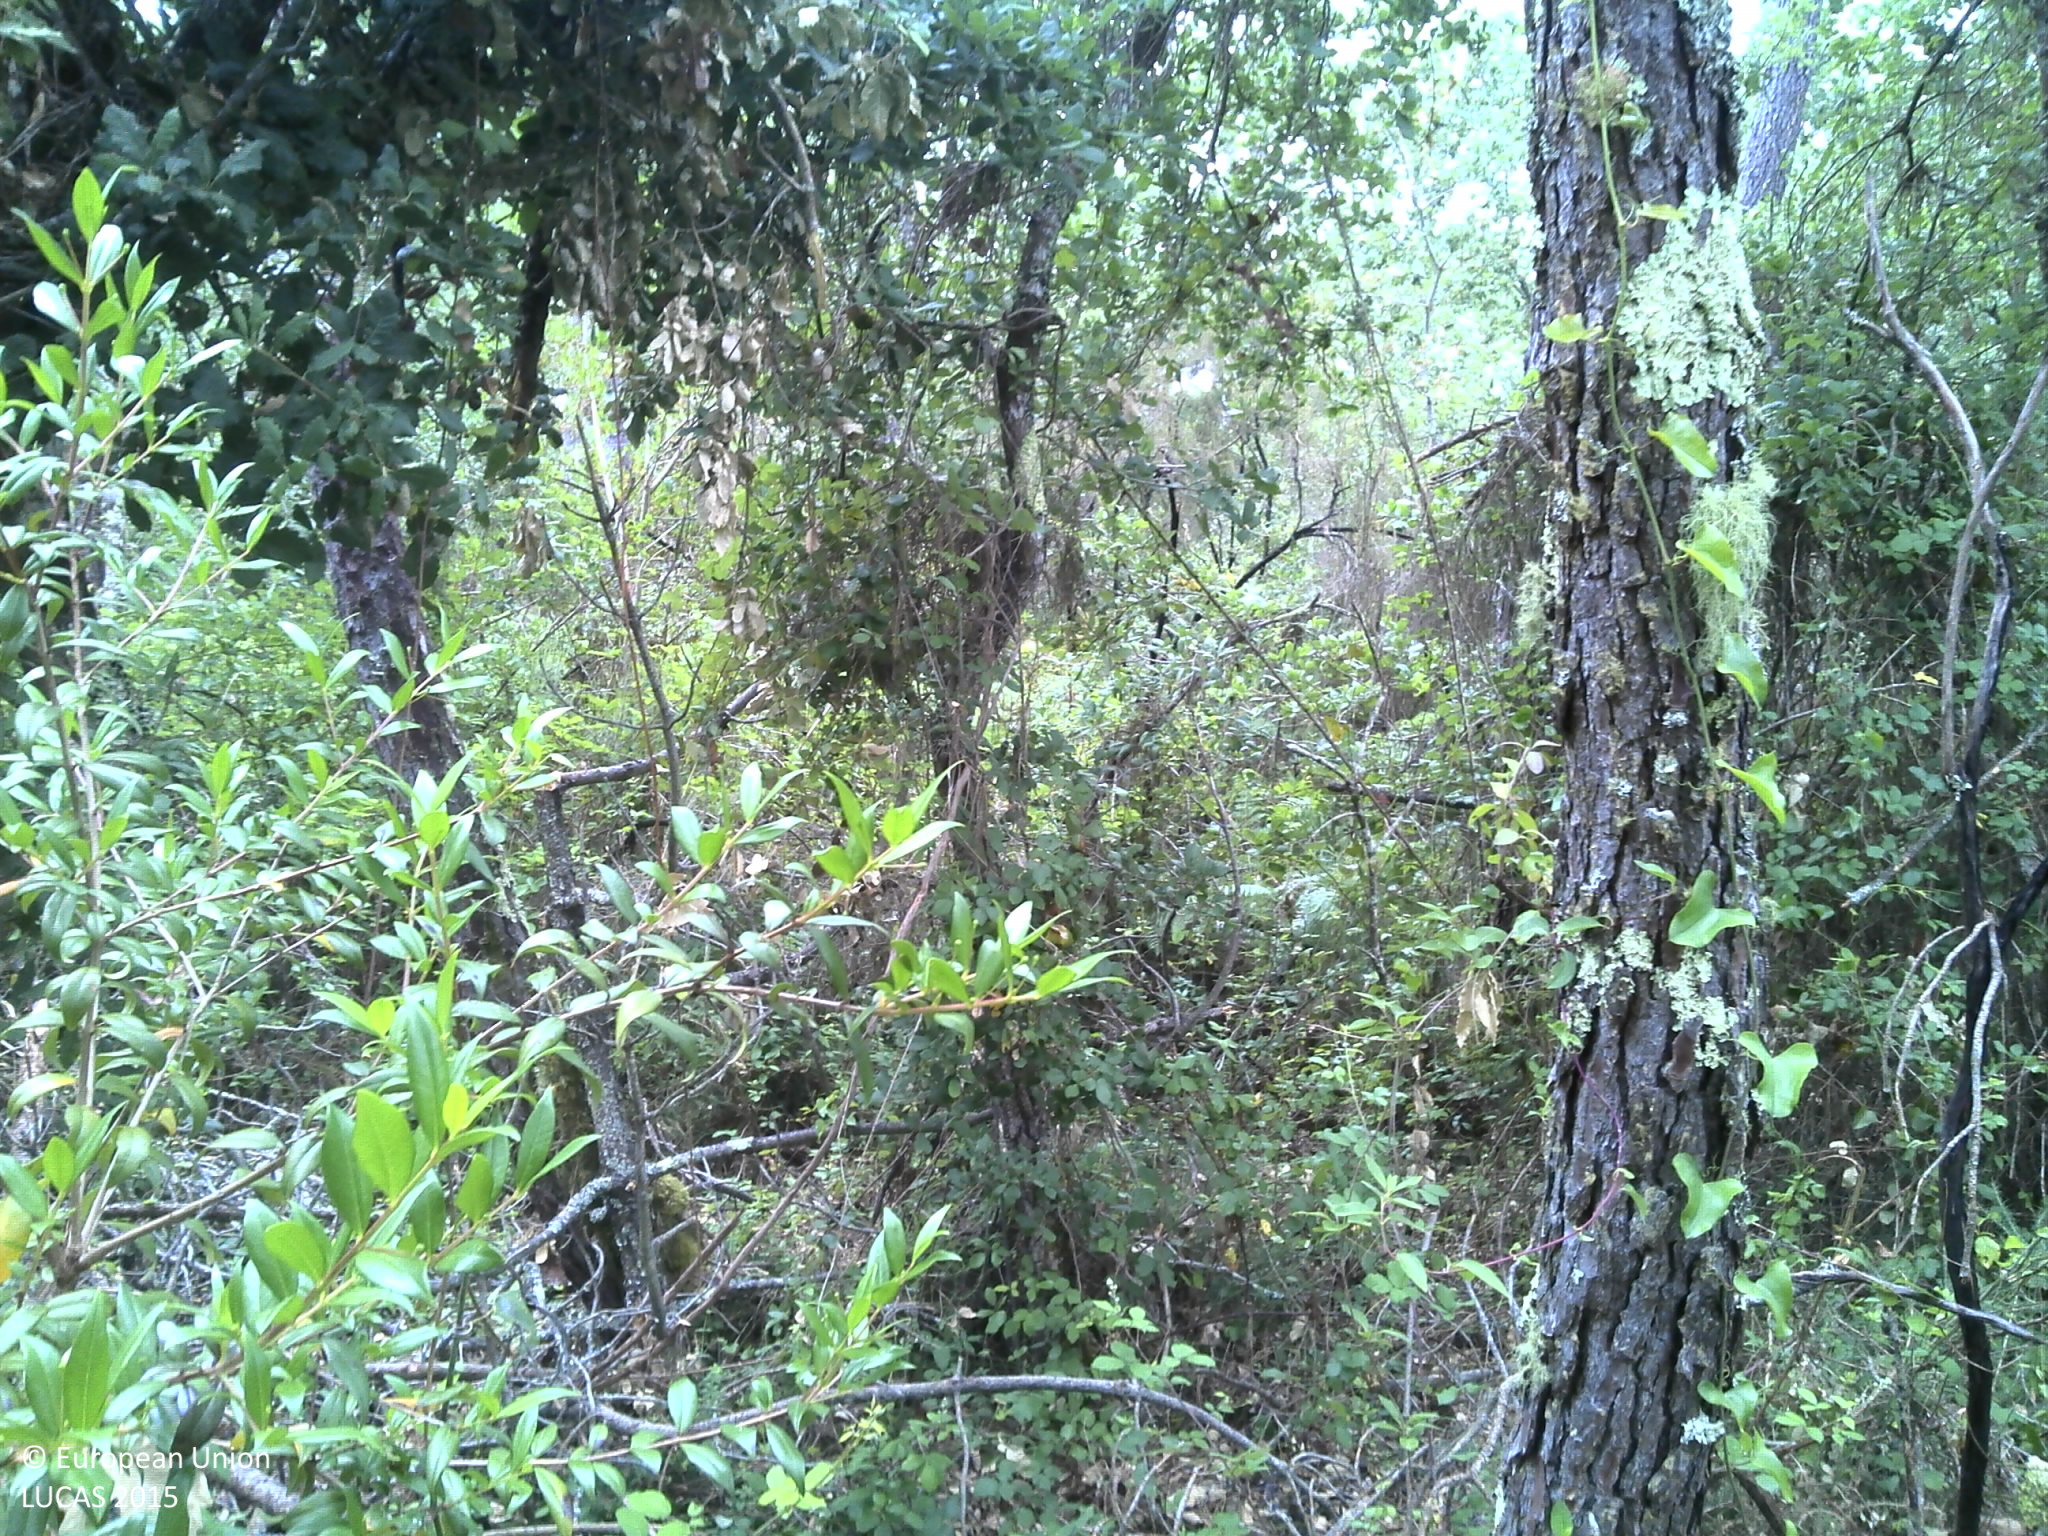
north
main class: Woodland
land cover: Pine dominated coniferous woodland
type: coniferous forest of the mediterranean region
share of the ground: > 75 %
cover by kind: coniferous forest trees 70 %, shrubs 25 %, unconsolidated bare surface 5 %
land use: Forestry
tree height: > 5 m
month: June
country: PT
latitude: 40.3077
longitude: -8.5742
